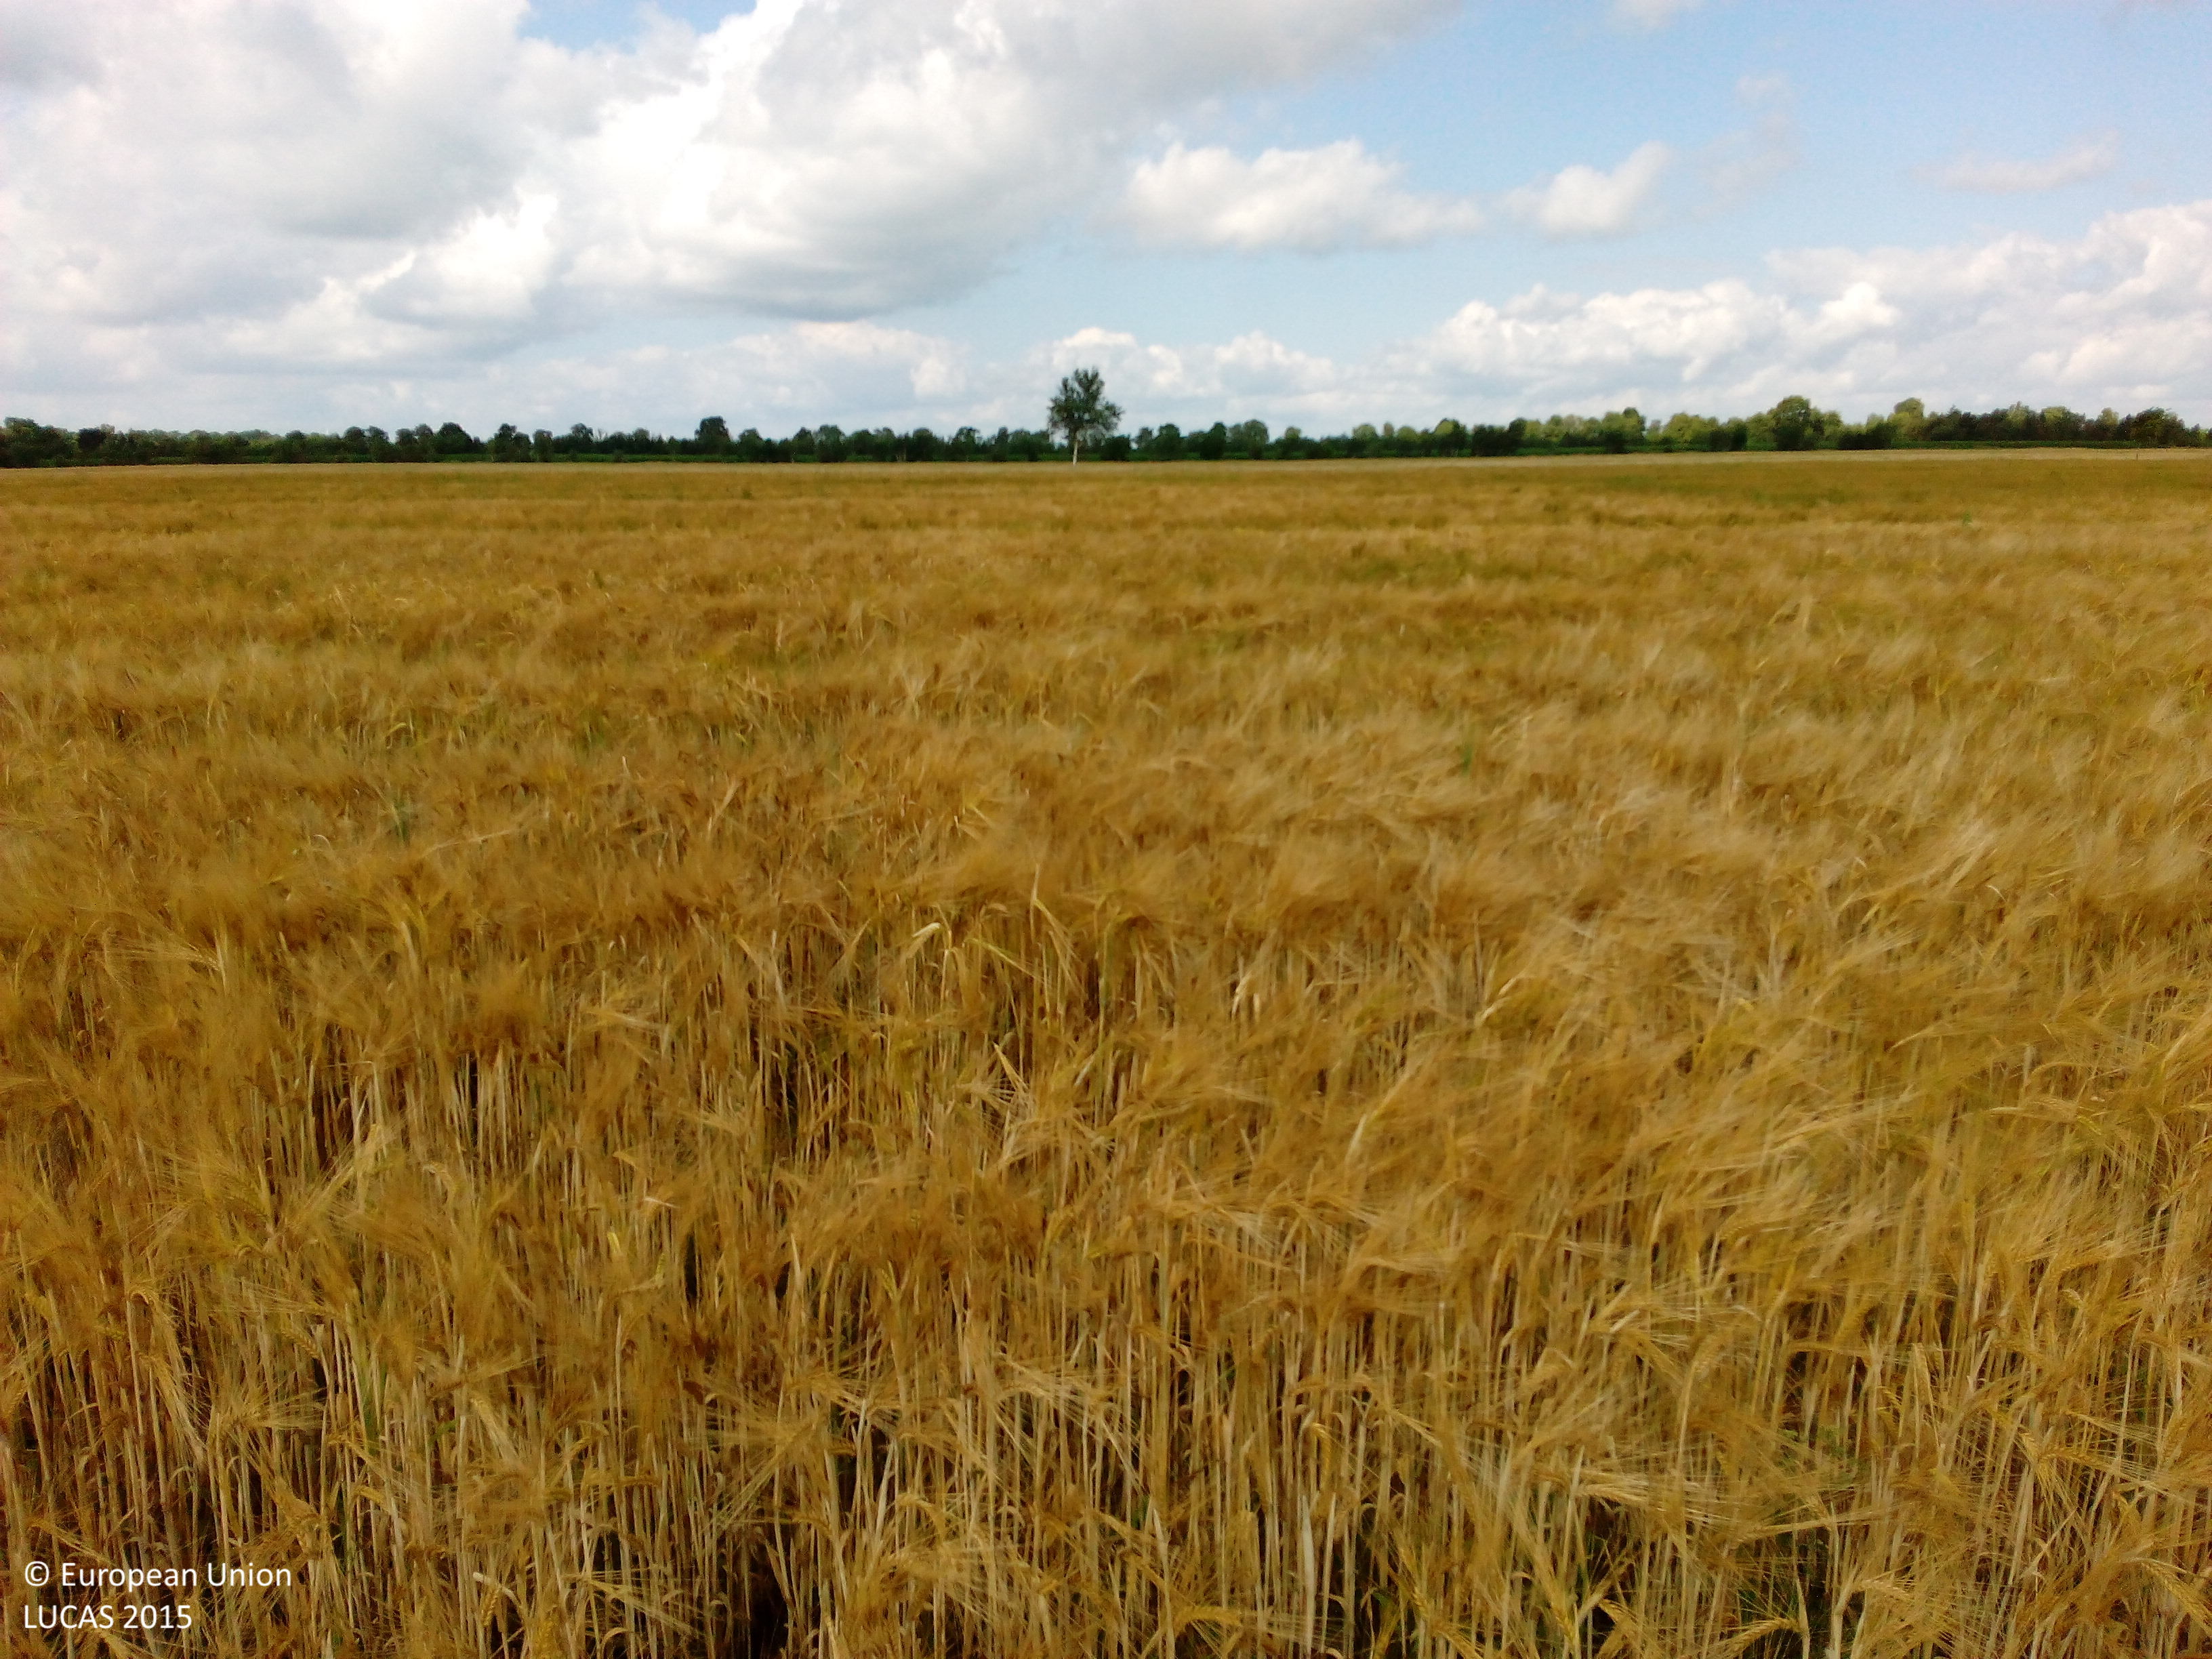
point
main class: Cropland
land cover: Barley
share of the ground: > 75 %
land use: Agriculture (excluding fallow land and kitchen gardens)
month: July
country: DE
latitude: 53.0960
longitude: 7.8950
